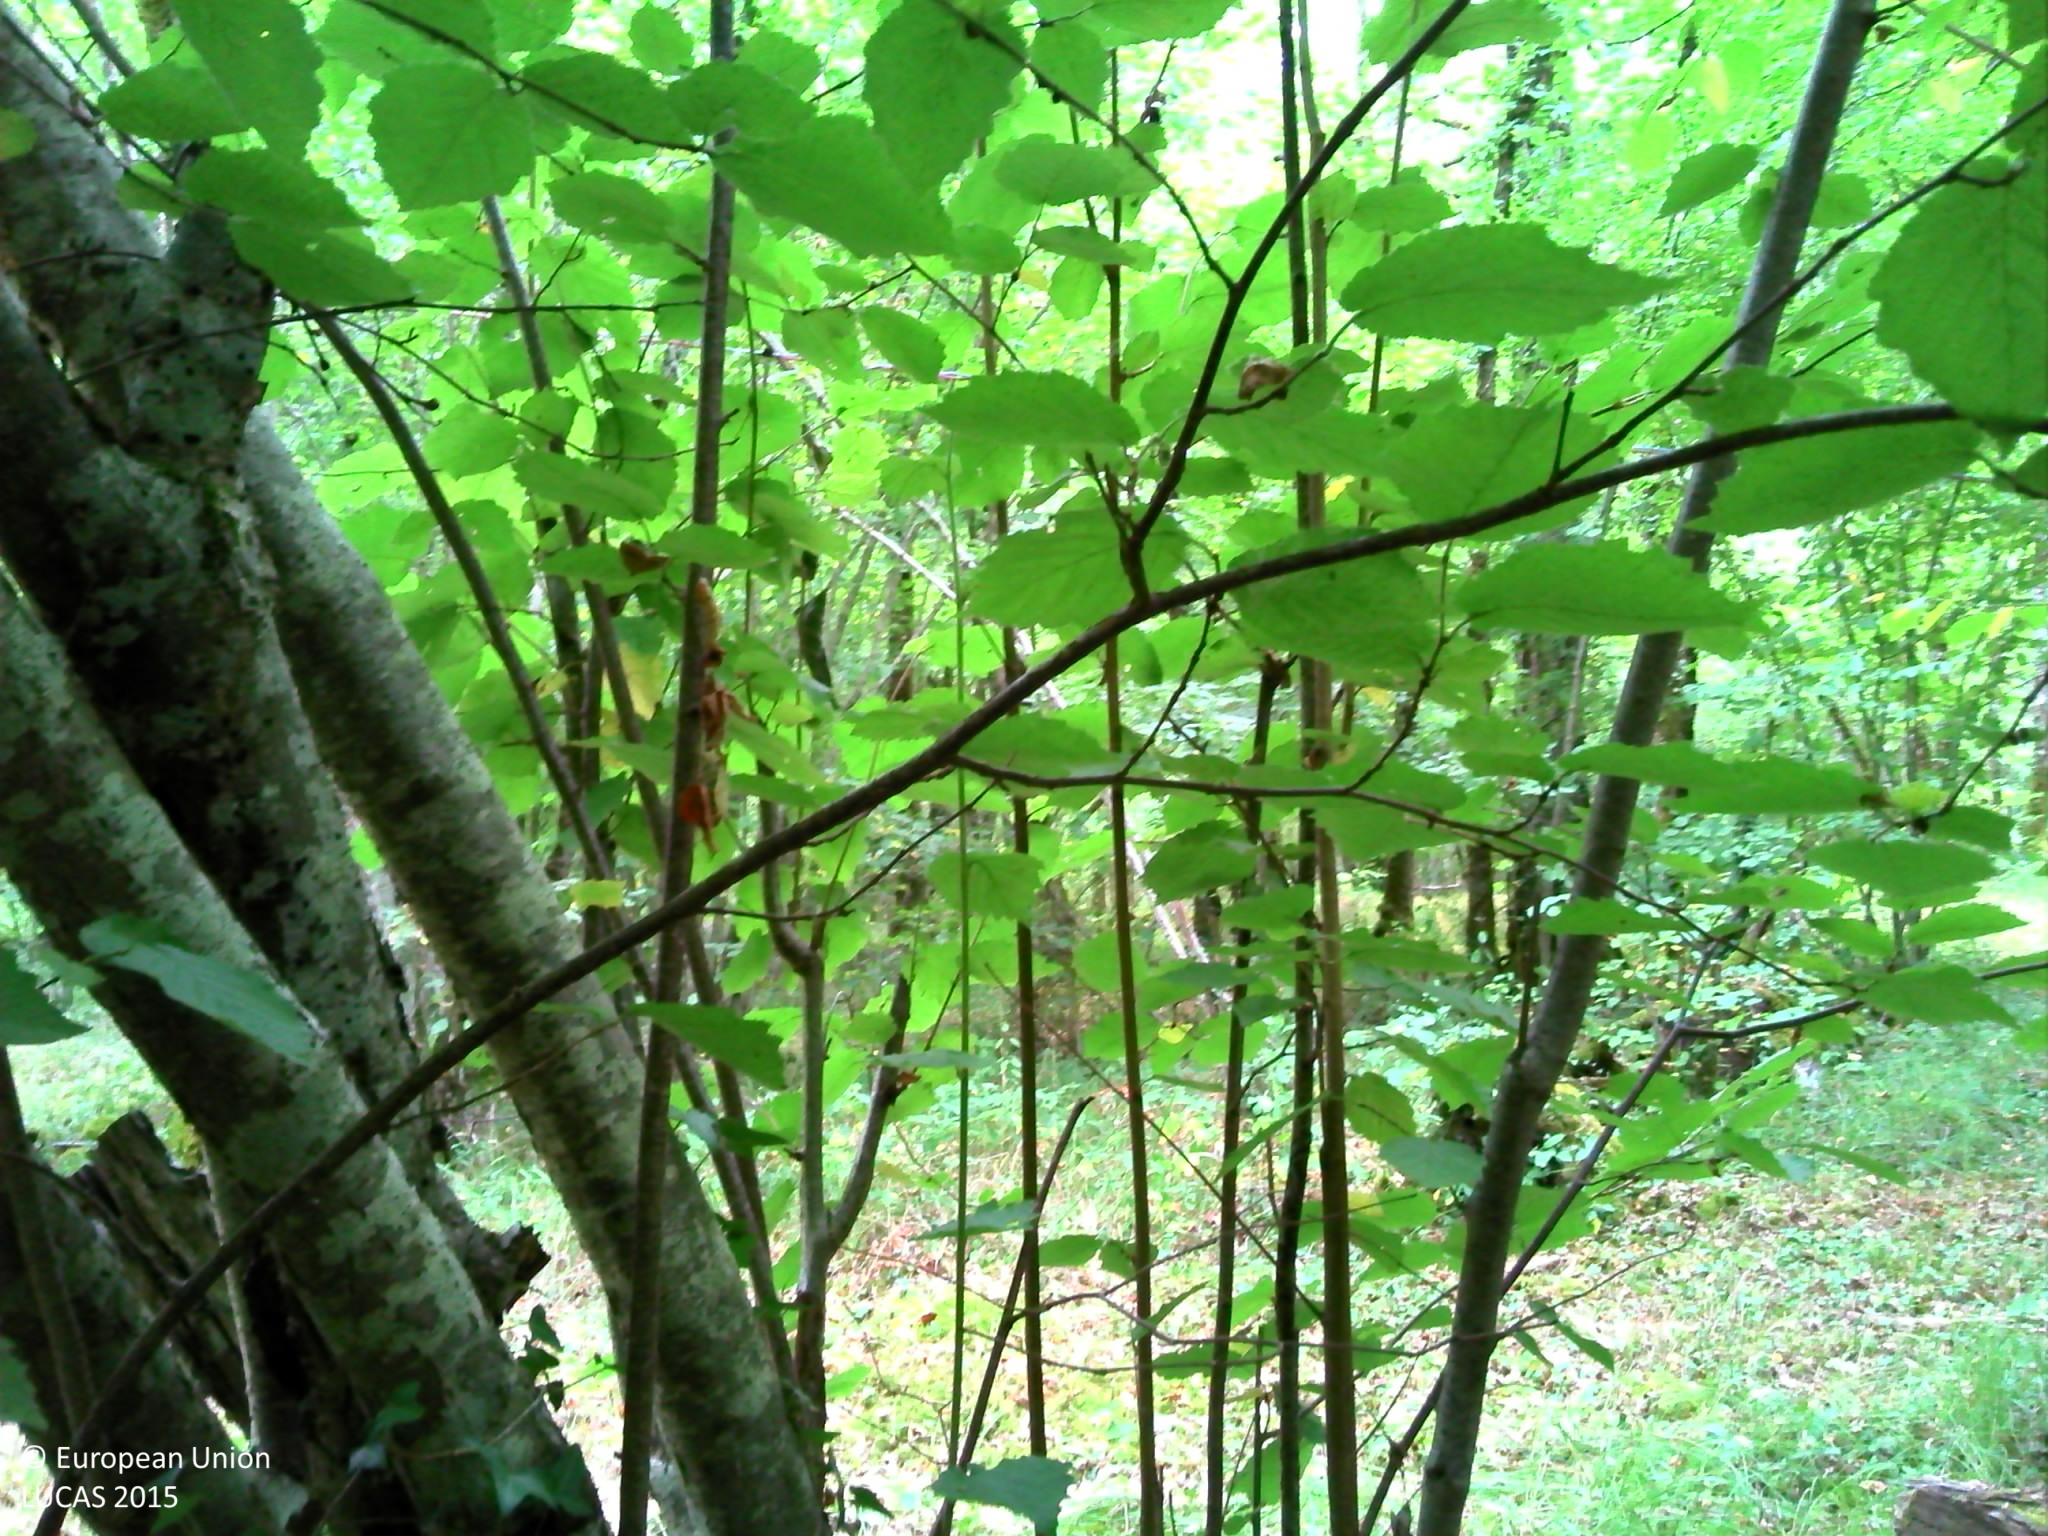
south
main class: Woodland
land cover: Broadleaved woodland
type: acidophilous oak and oak-birch forest
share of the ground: > 75 %
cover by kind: broadleaved forest trees 70 %, herbaceous plants 20 %, shrubs 5 %, lichens and mosses 5 %
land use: Forestry
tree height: > 5 m
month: July
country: FR
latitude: 44.8632
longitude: 0.7660
